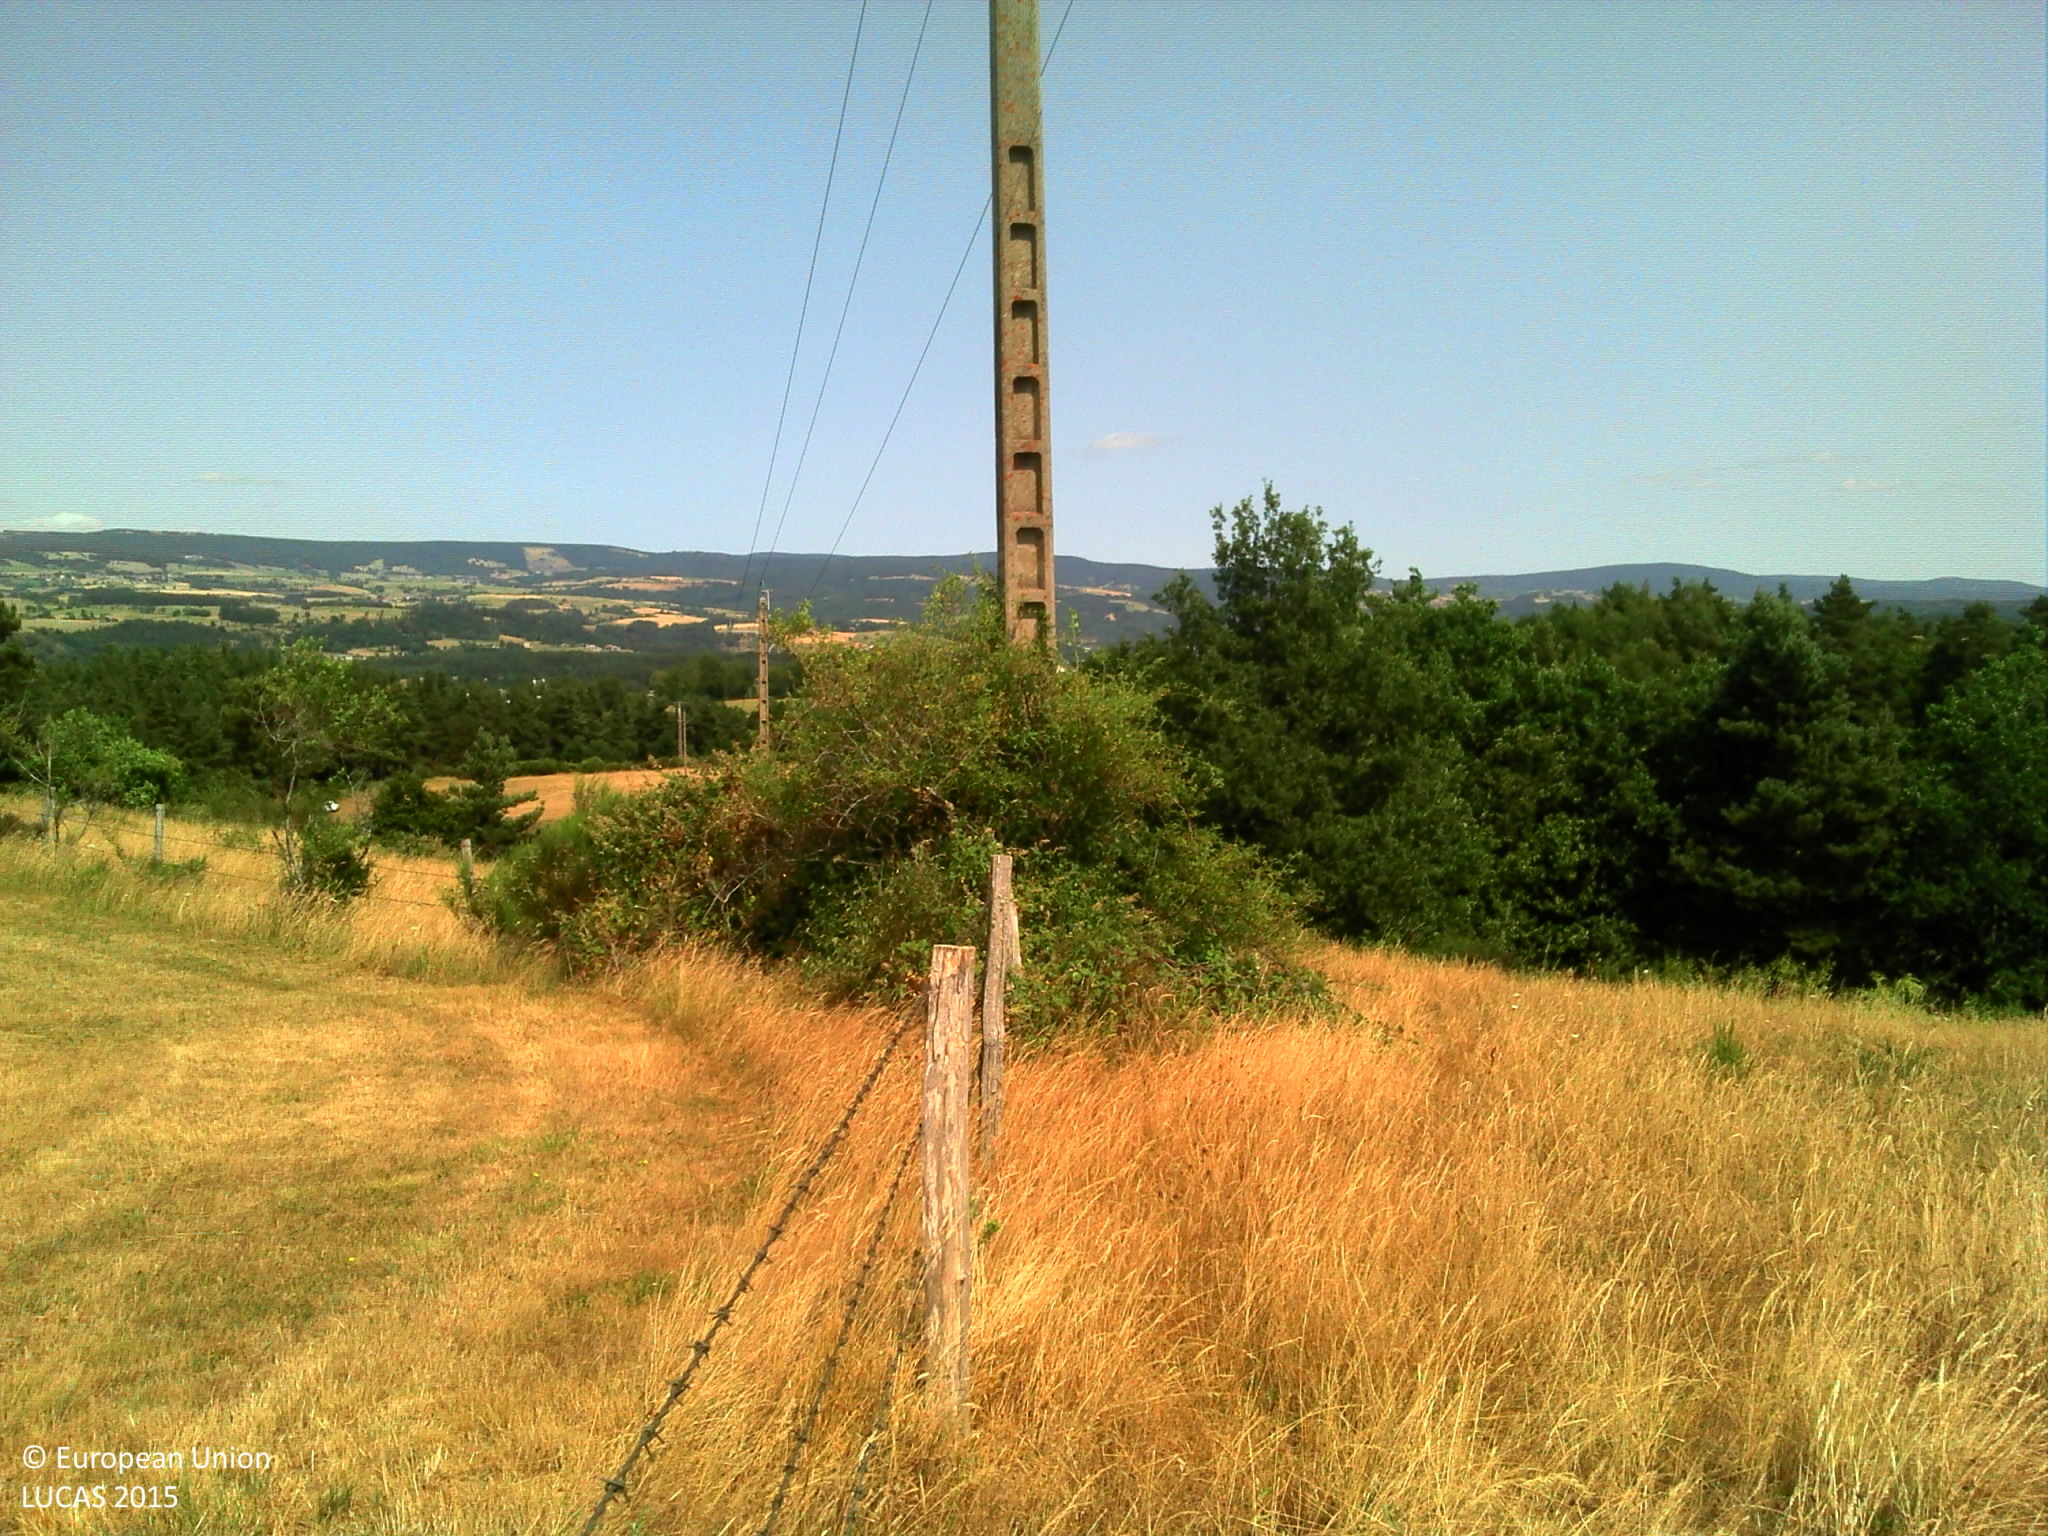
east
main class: Grassland
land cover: Grassland without tree/shrub cover
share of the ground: > 75 %
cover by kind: herbaceous plants 100 %
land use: Agriculture (excluding fallow land and kitchen gardens)
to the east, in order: Fences; Electric lines; Abandoned hedges; Grassland without tree/shrub cover; Broadleaved woodland; Grassland without tree/shrub cover; Fences; Grassland without tree/shrub cover; Fences; Shrubland with sparse tree cover; Spruce dominated mixed woodland; Grassland without tree/shrub cover; Fences; Broadleaved woodland; Grassland without tree/shrub cover
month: July
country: FR
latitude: 44.9592
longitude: 3.1954
